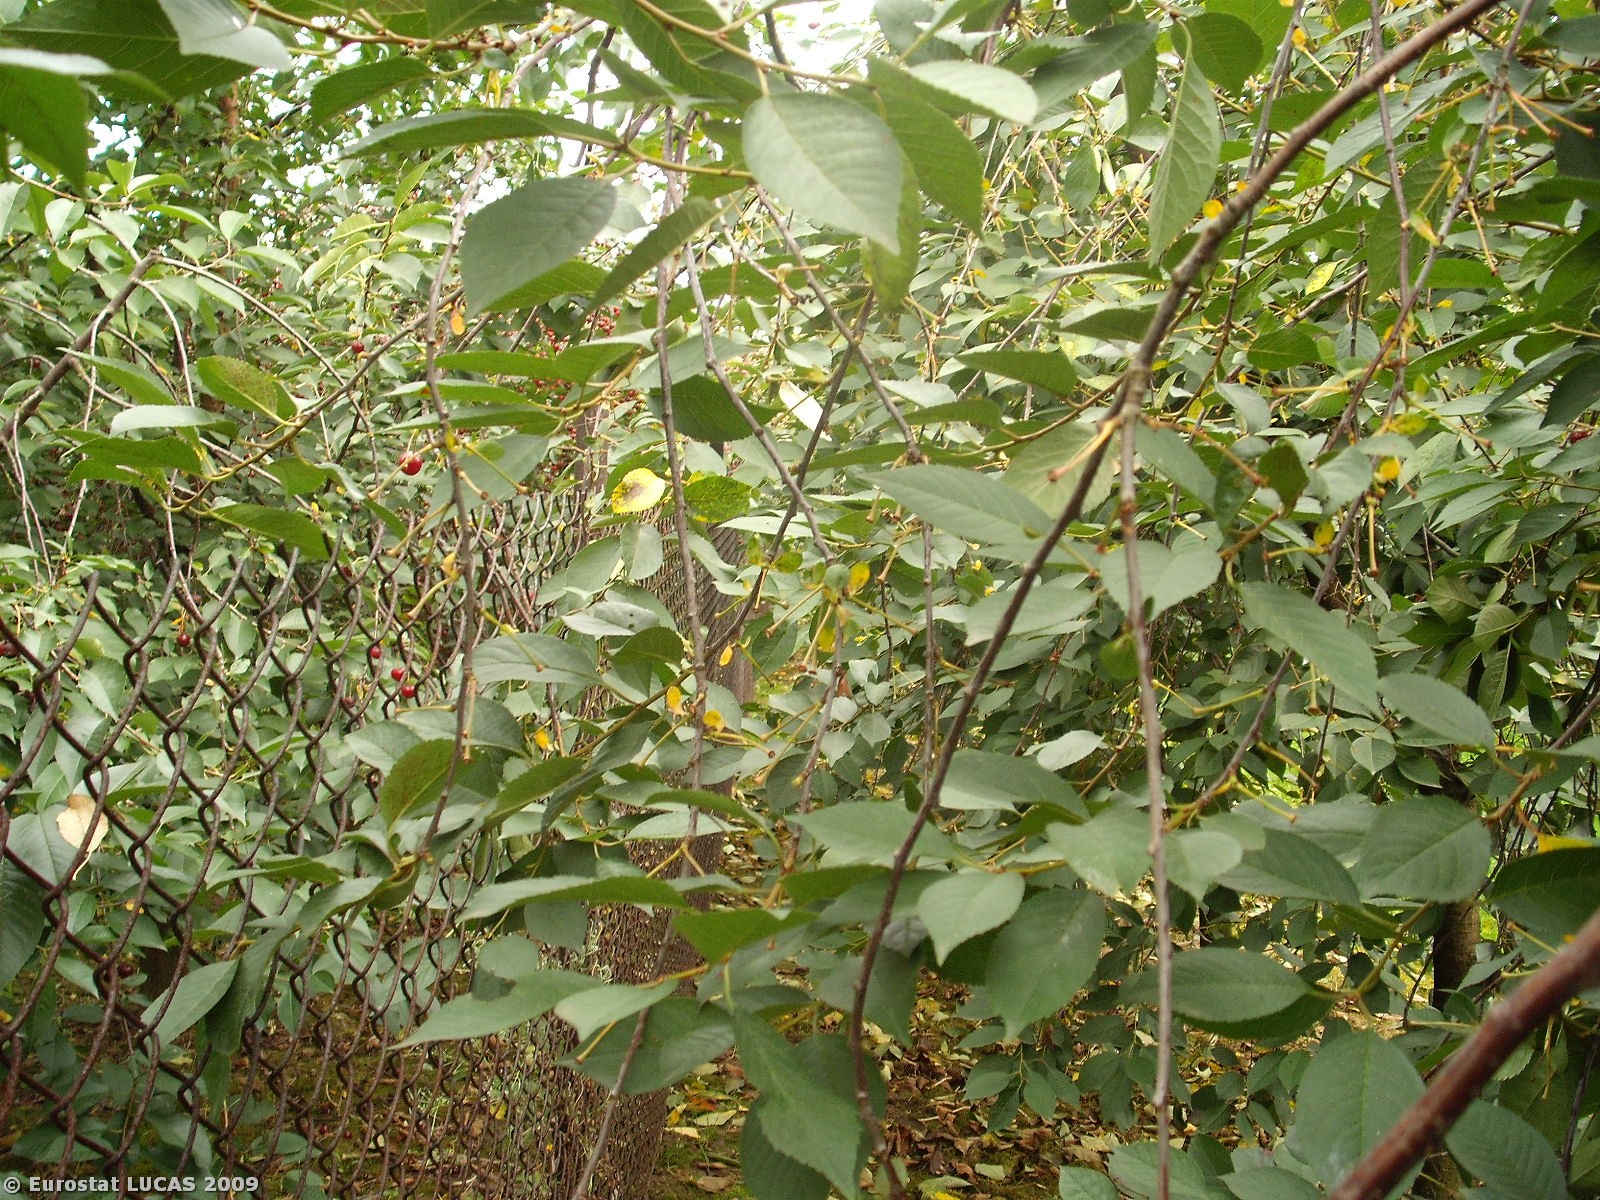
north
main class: Cropland
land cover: Cherry fruit
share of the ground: 50 - 75 %
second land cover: Grassland with sparse tree/shrub cover
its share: > 75 %
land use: Agriculture (excluding fallow land and kitchen gardens)
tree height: < 5 m
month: August
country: PL
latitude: 51.7970
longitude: 21.1389
